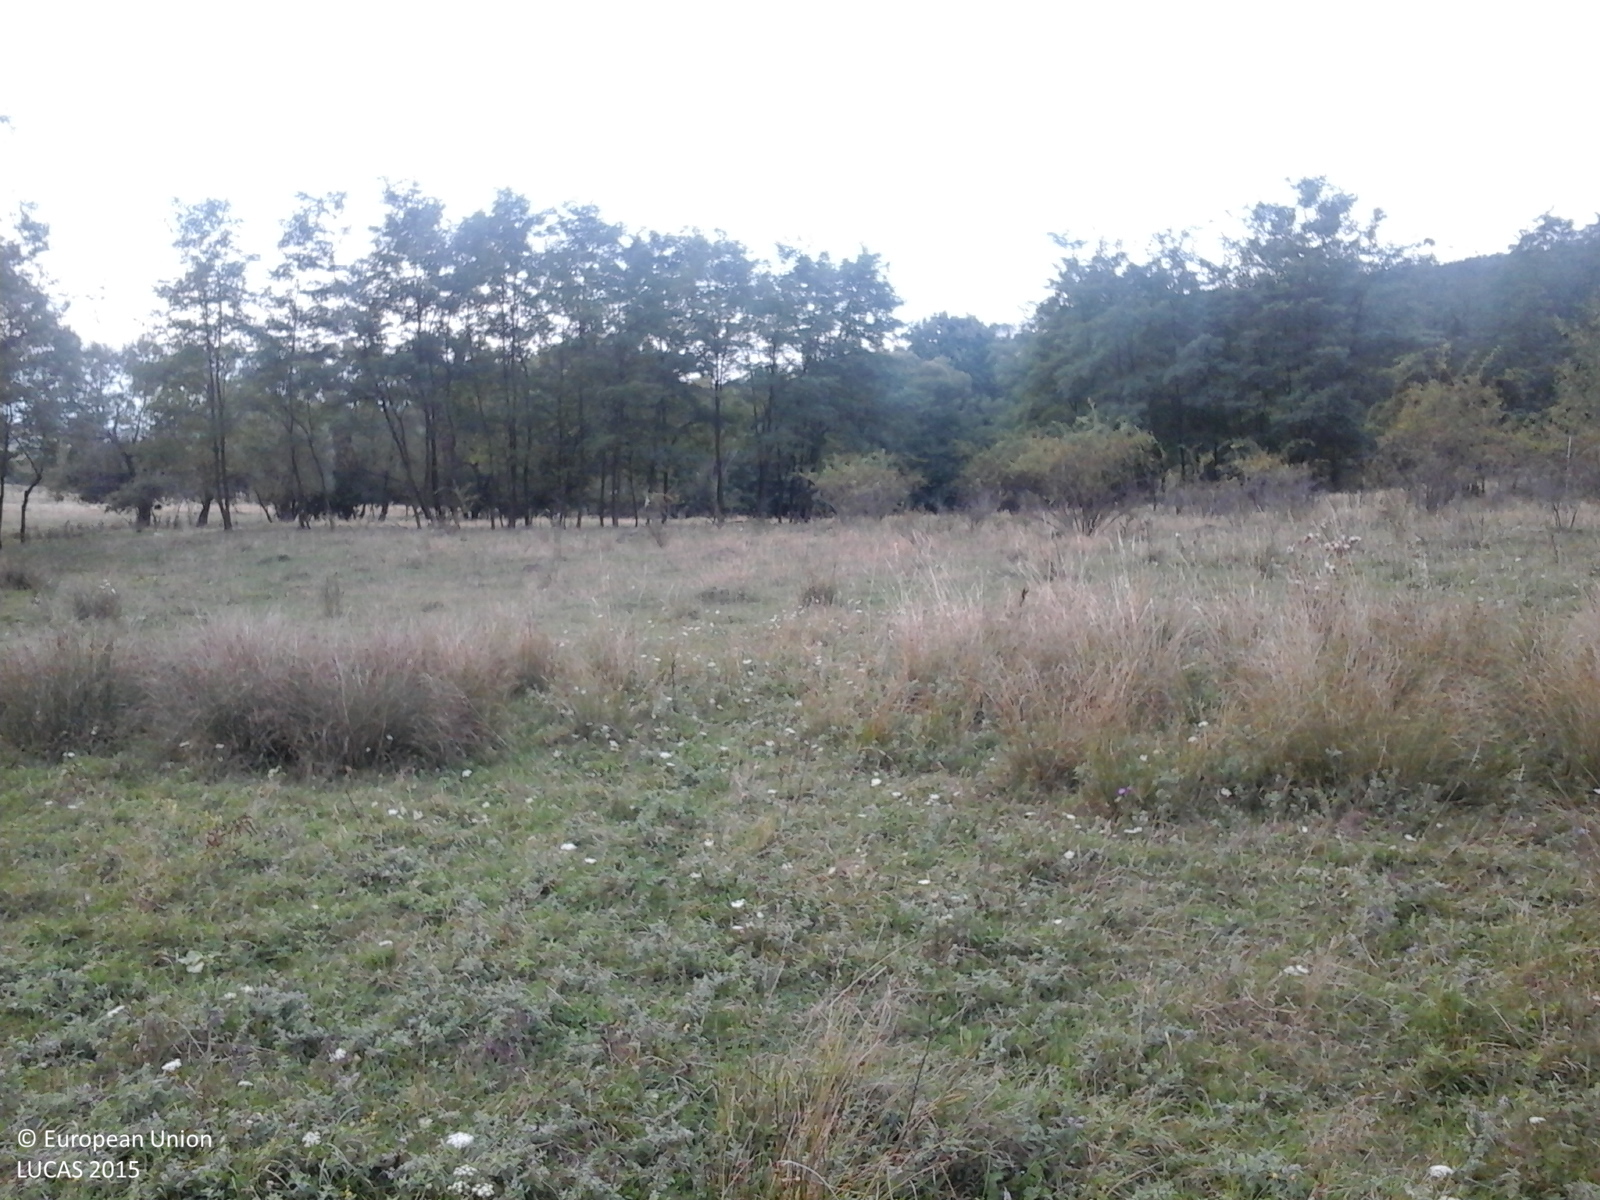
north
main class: Grassland
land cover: Grassland without tree/shrub cover
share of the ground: > 75 %
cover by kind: herbaceous plants 100 %
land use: Agriculture (excluding fallow land and kitchen gardens)
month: September
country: RO
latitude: 47.1402
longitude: 22.9981
